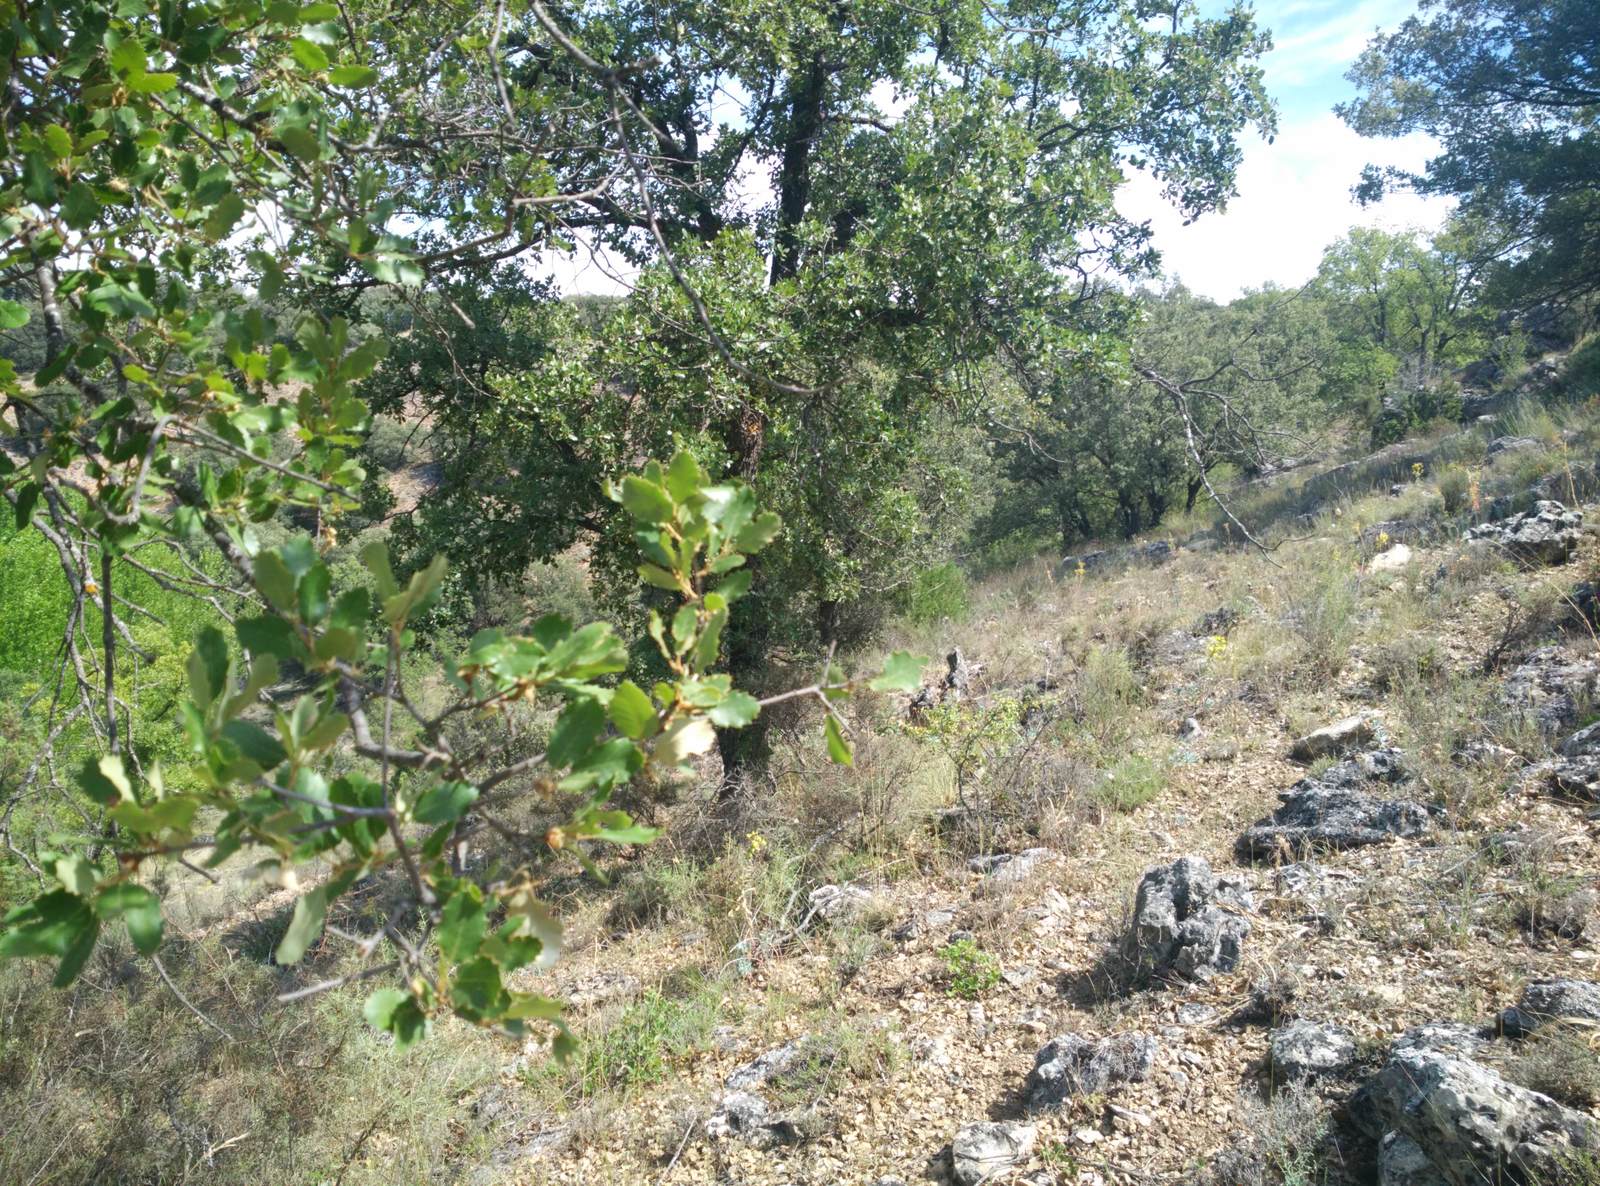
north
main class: Shrubland
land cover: Shrubland with sparse tree cover
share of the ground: 50 - 75 %
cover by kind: shrubs 50 %, unconsolidated bare surface 40 %, broadleaved forest trees 5 %, herbaceous plants 5 %
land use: Semi-natural and natural areas not in use
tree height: < 5 m
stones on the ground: > 50 %
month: July
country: ES
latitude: 40.8927
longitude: -2.6235
